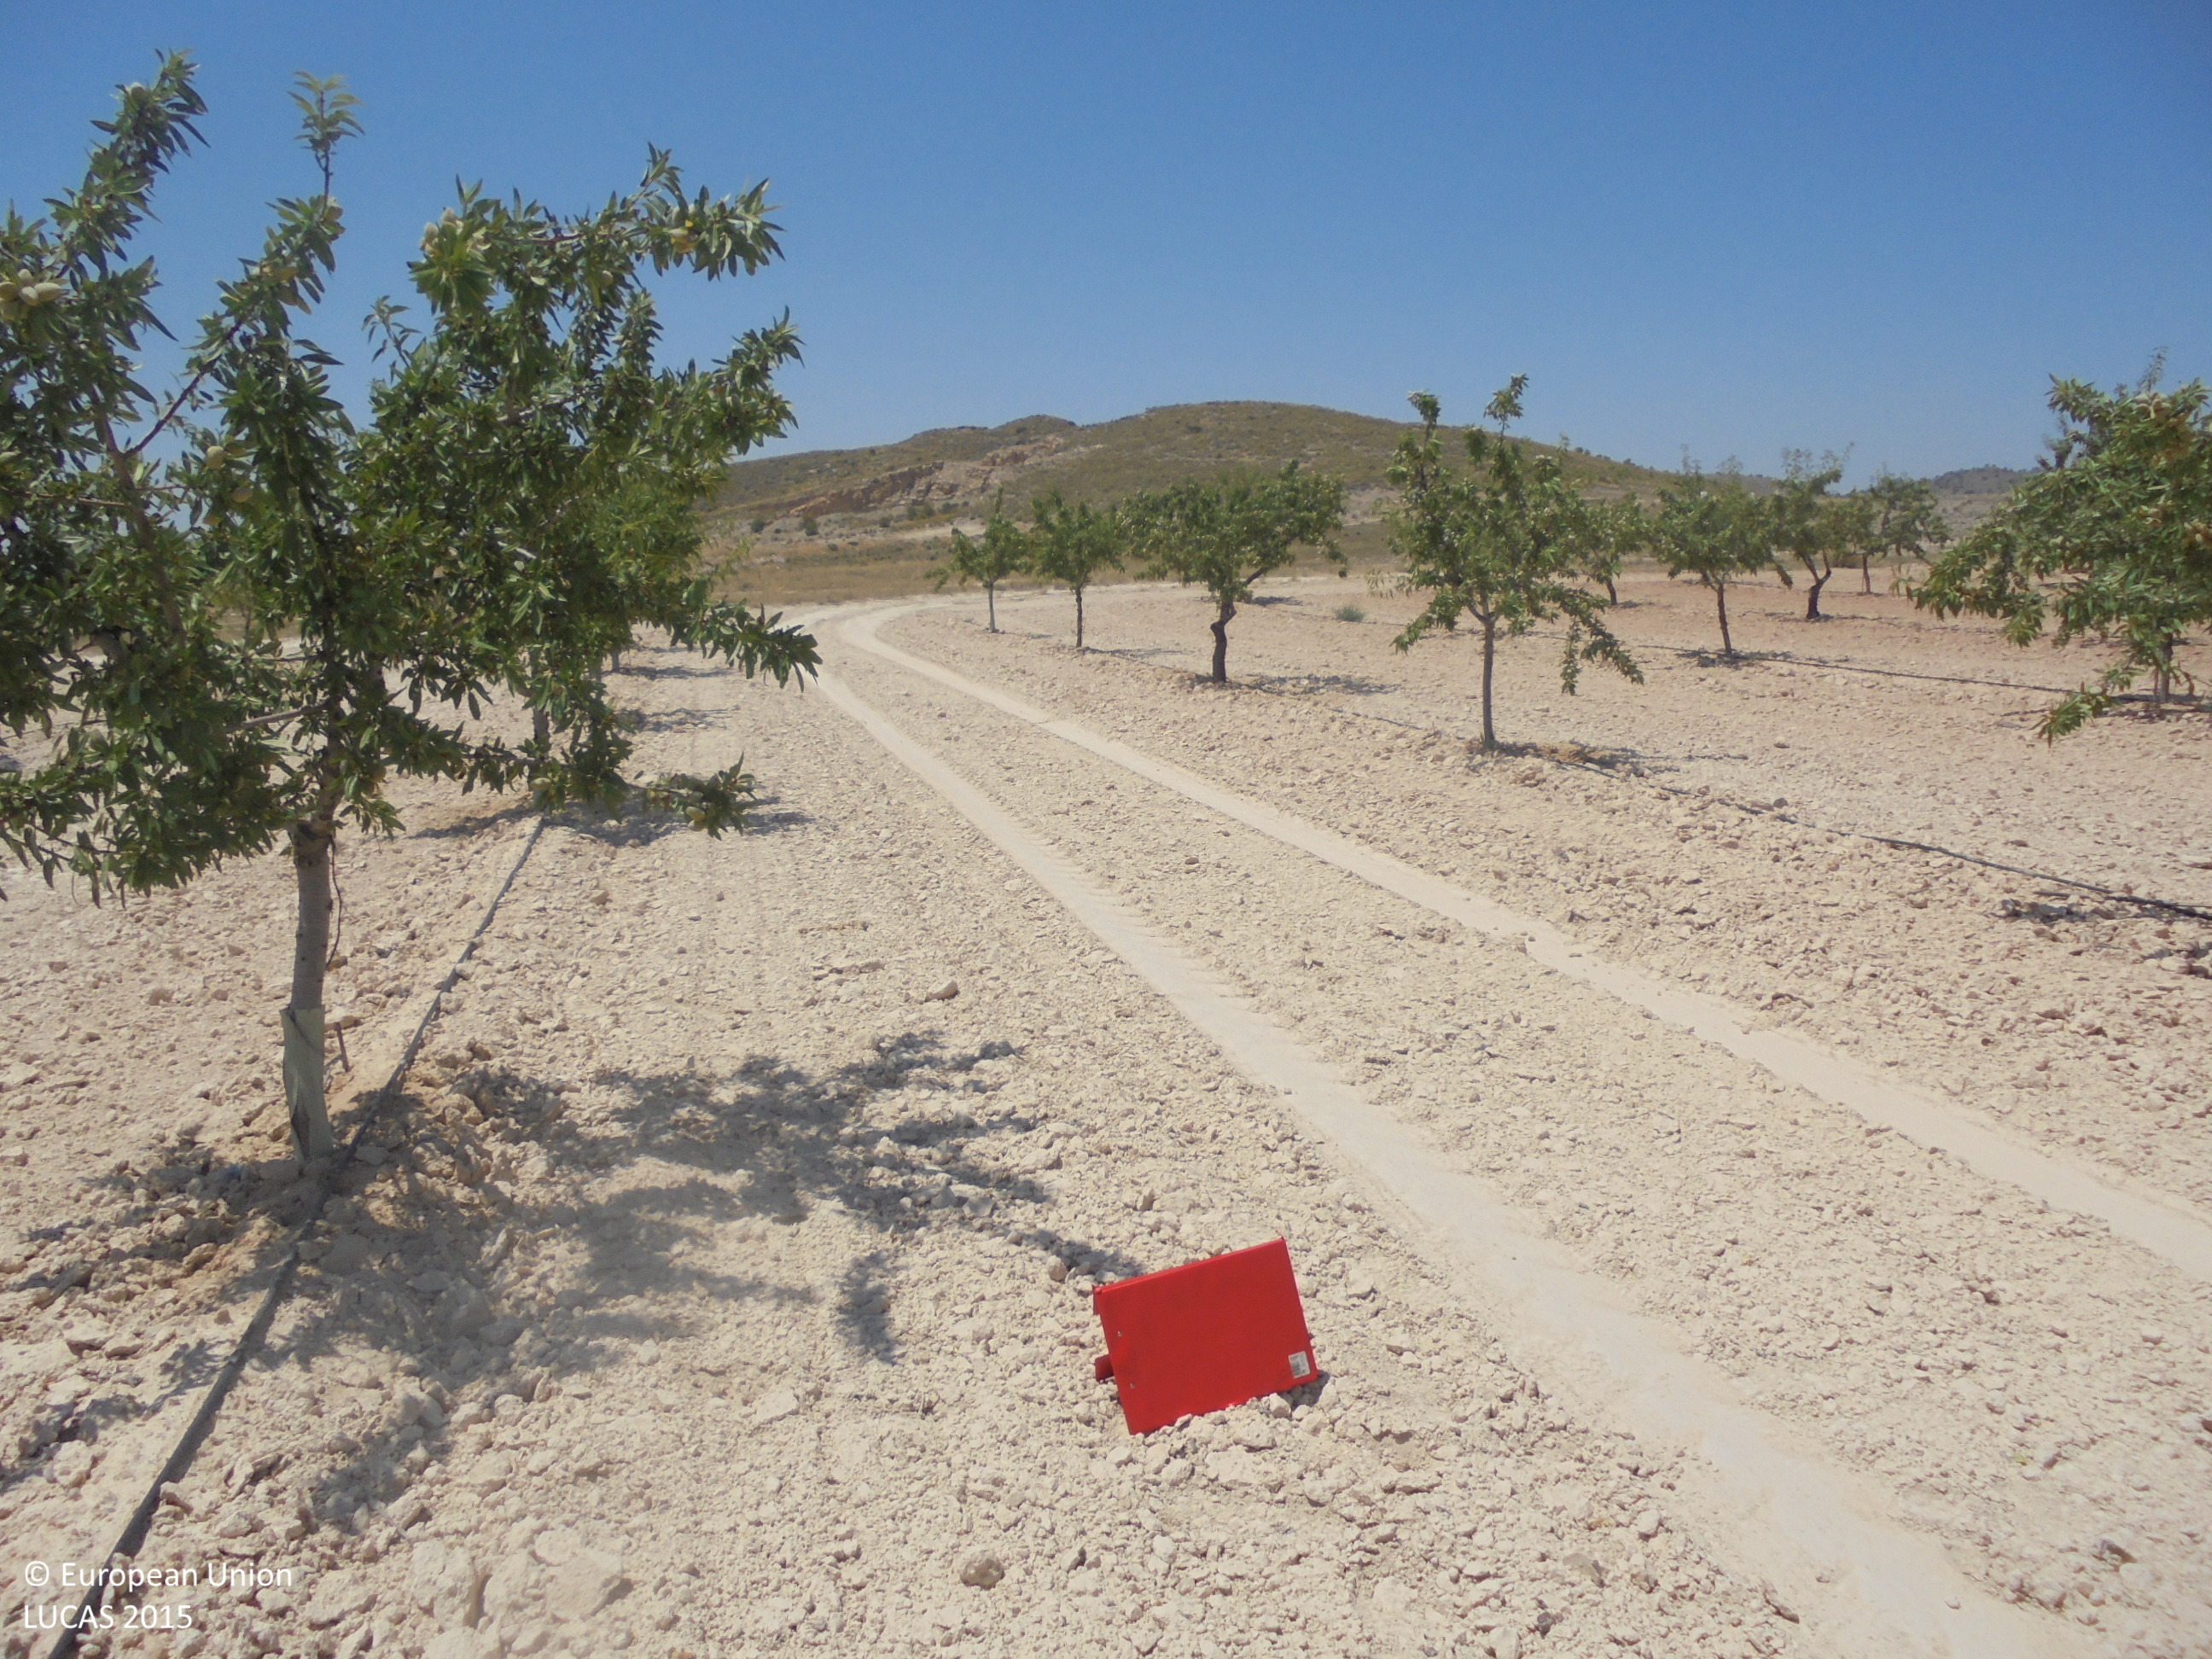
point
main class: Cropland
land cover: Nuts trees
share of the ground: 10 - 25 %
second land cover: Other bare soil
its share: > 75 %
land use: Agriculture (excluding fallow land and kitchen gardens)
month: July
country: ES
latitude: 38.5982
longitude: -1.5328
